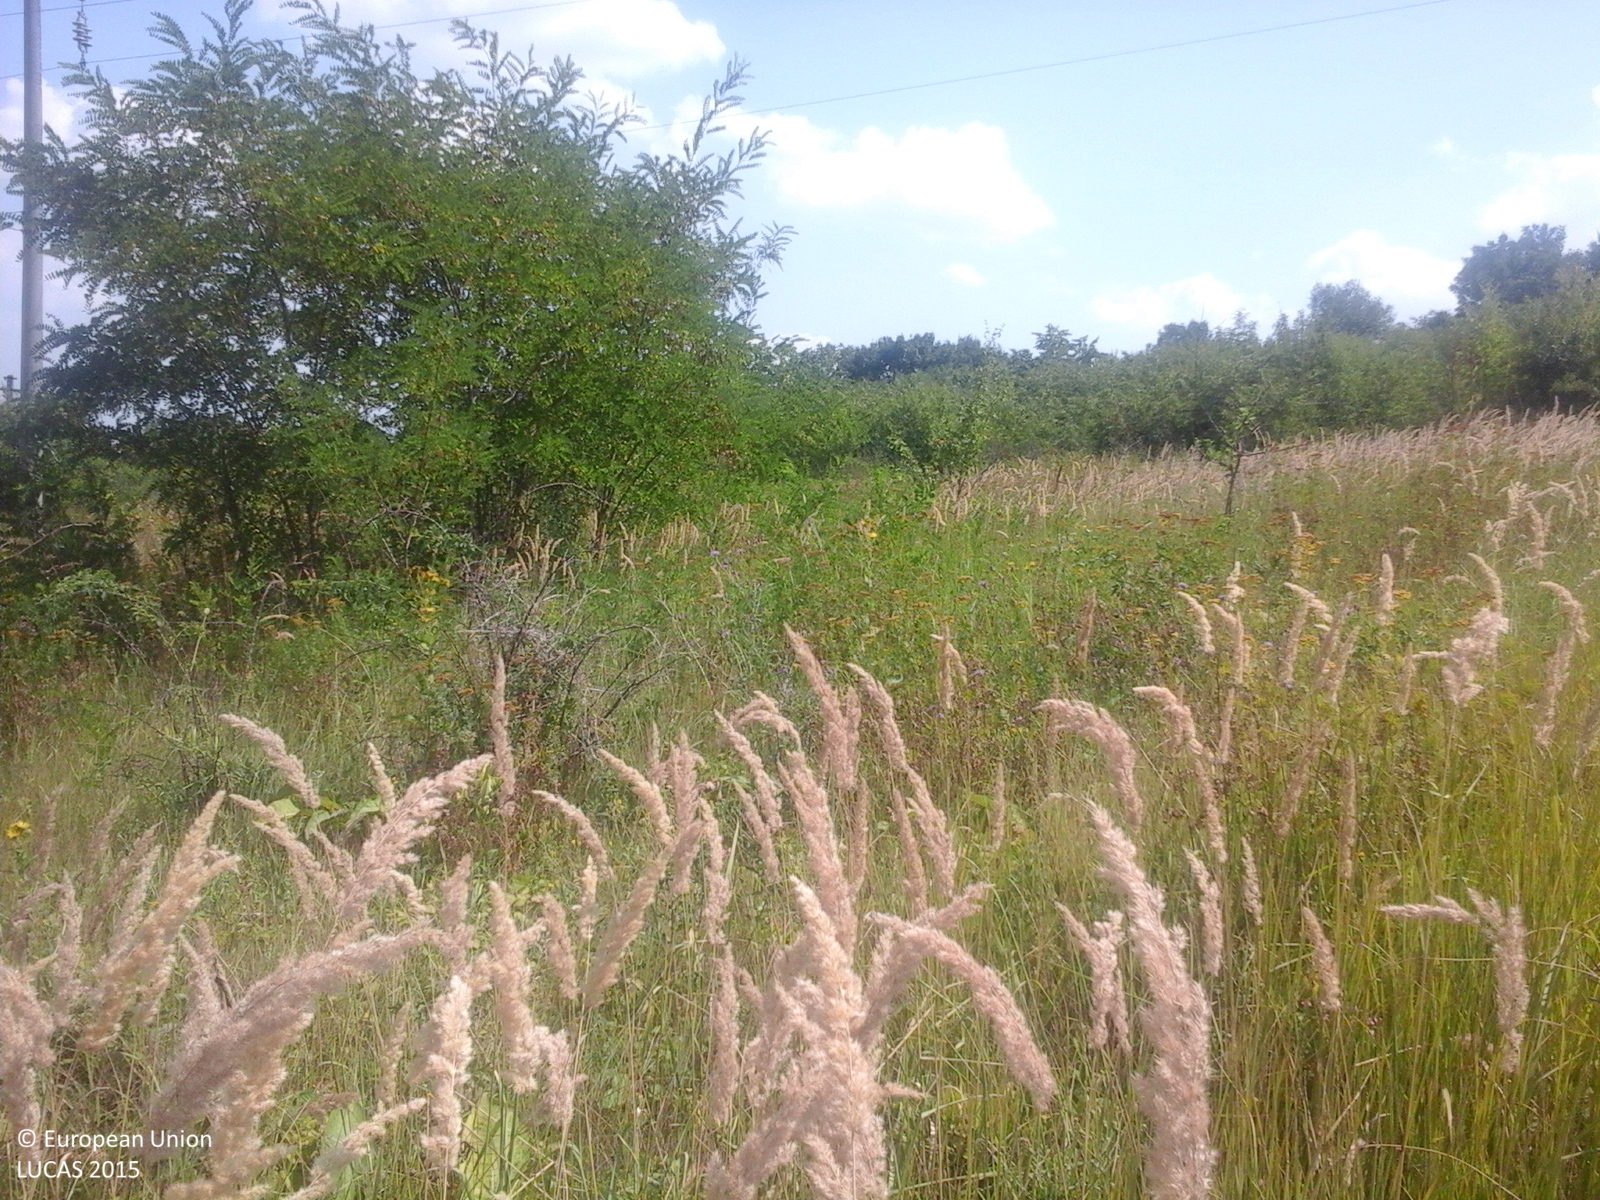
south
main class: Grassland
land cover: Spontaneously vegetated surfaces
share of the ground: > 75 %
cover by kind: herbaceous plants 100 %
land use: Fallow land
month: July
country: RO
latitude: 46.6662
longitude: 28.0215
